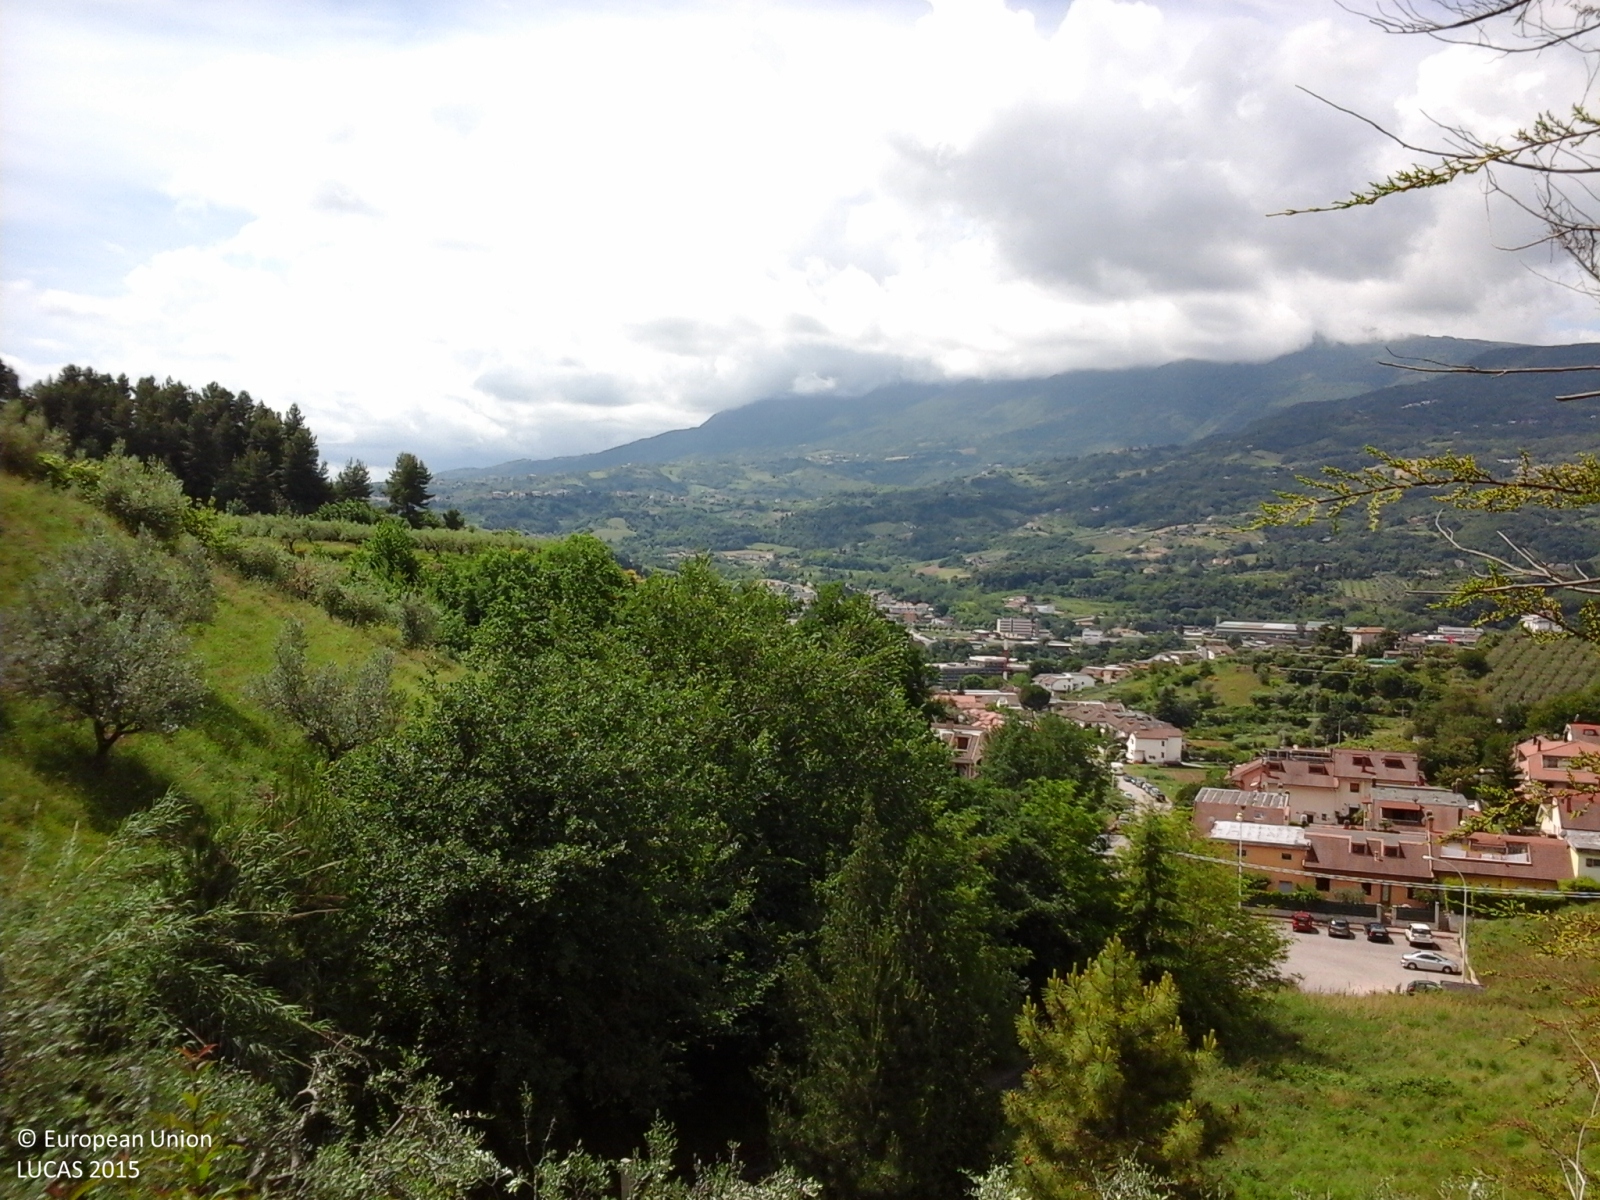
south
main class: Cropland
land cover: Olive groves
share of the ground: > 75 %
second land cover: Grassland without tree/shrub cover
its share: > 75 %
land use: Agriculture (excluding fallow land and kitchen gardens)
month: May
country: IT
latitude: 42.8603
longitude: 13.6248
